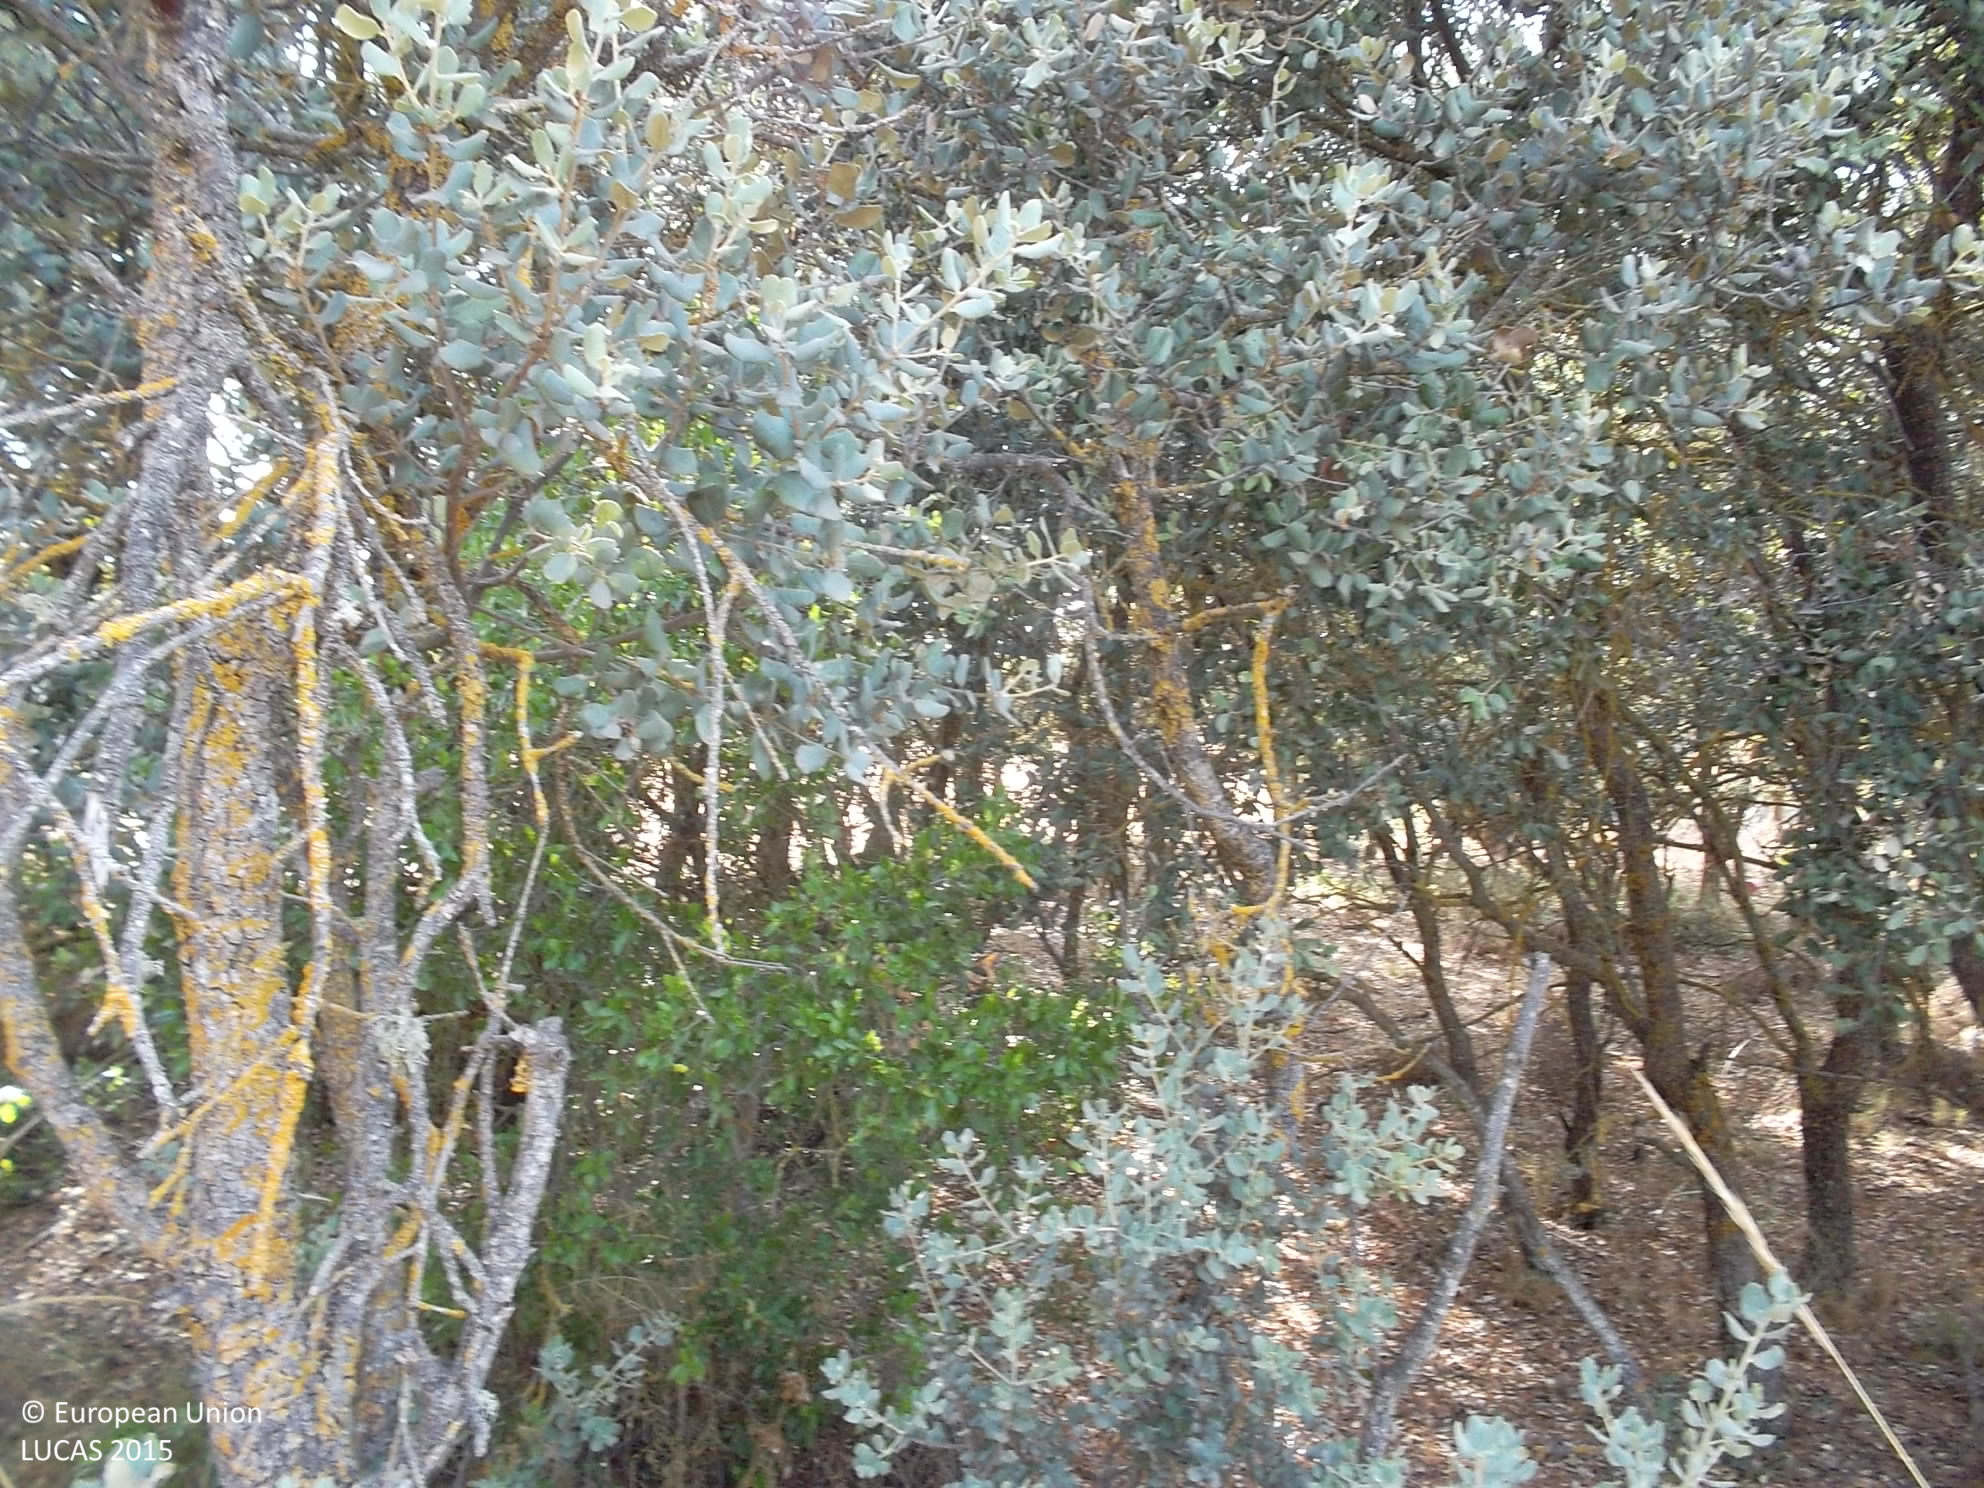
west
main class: Woodland
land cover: Broadleaved woodland
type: broadleaved evergreen forest
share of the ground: 50 - 75 %
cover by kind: broadleaved forest trees 40 %, shrubs 30 %, herbaceous plants 20 %, unconsolidated bare surface 10 %
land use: Semi-natural and natural areas not in use
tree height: > 5 m
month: June
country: ES
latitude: 37.6982
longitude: -2.8407
